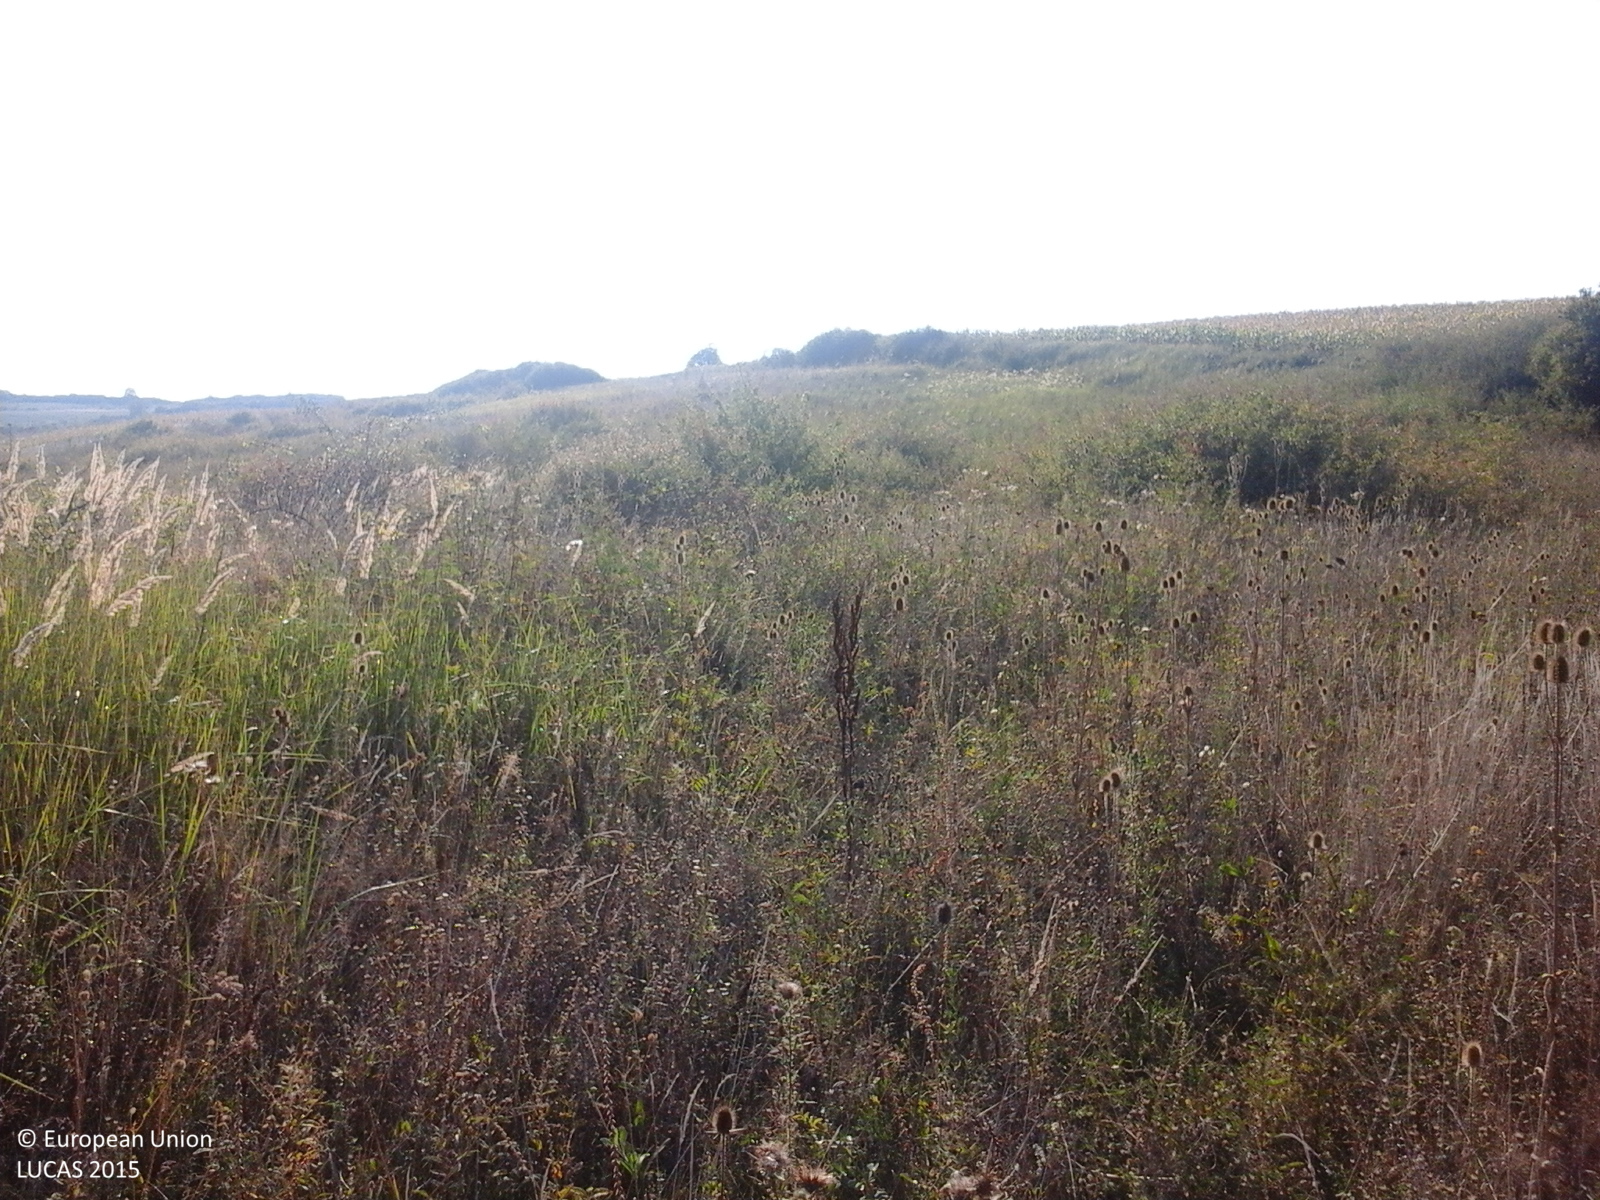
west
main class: Grassland
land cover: Spontaneously vegetated surfaces
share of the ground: > 75 %
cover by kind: herbaceous plants 100 %
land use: Fallow land
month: September
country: RO
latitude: 47.3139
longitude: 23.0689
